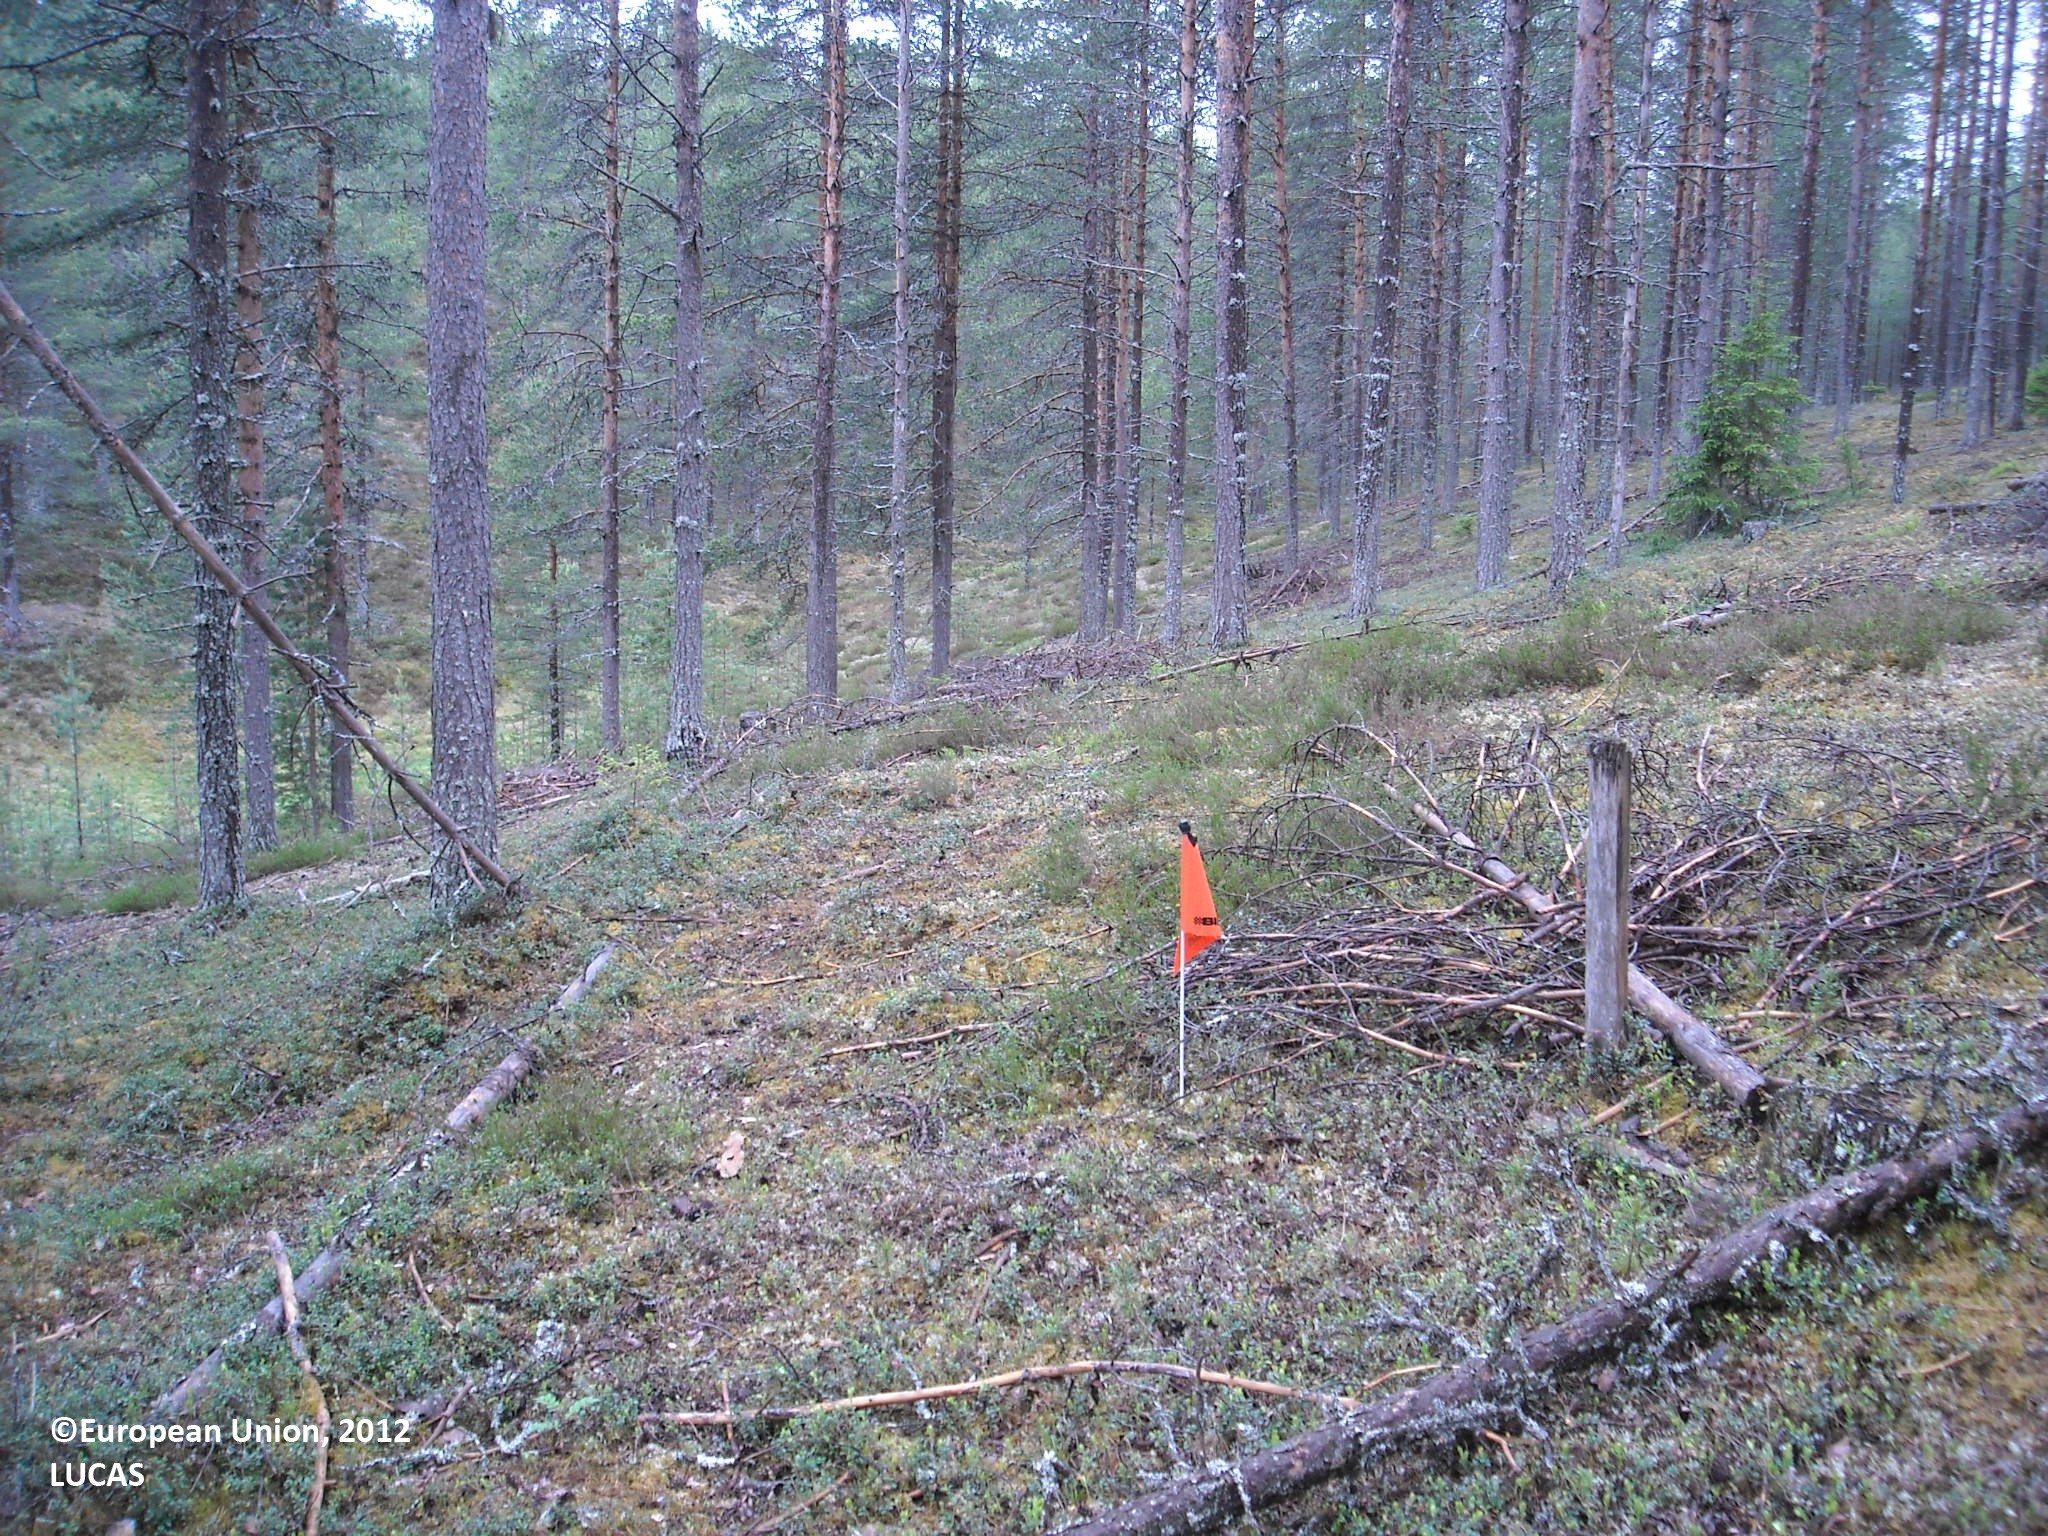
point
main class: Woodland
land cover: Pine dominated coniferous woodland
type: boreal forest
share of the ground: 50 - 75 %
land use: Forestry
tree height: > 5 m
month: June
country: FI
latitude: 65.5075
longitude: 27.9338
